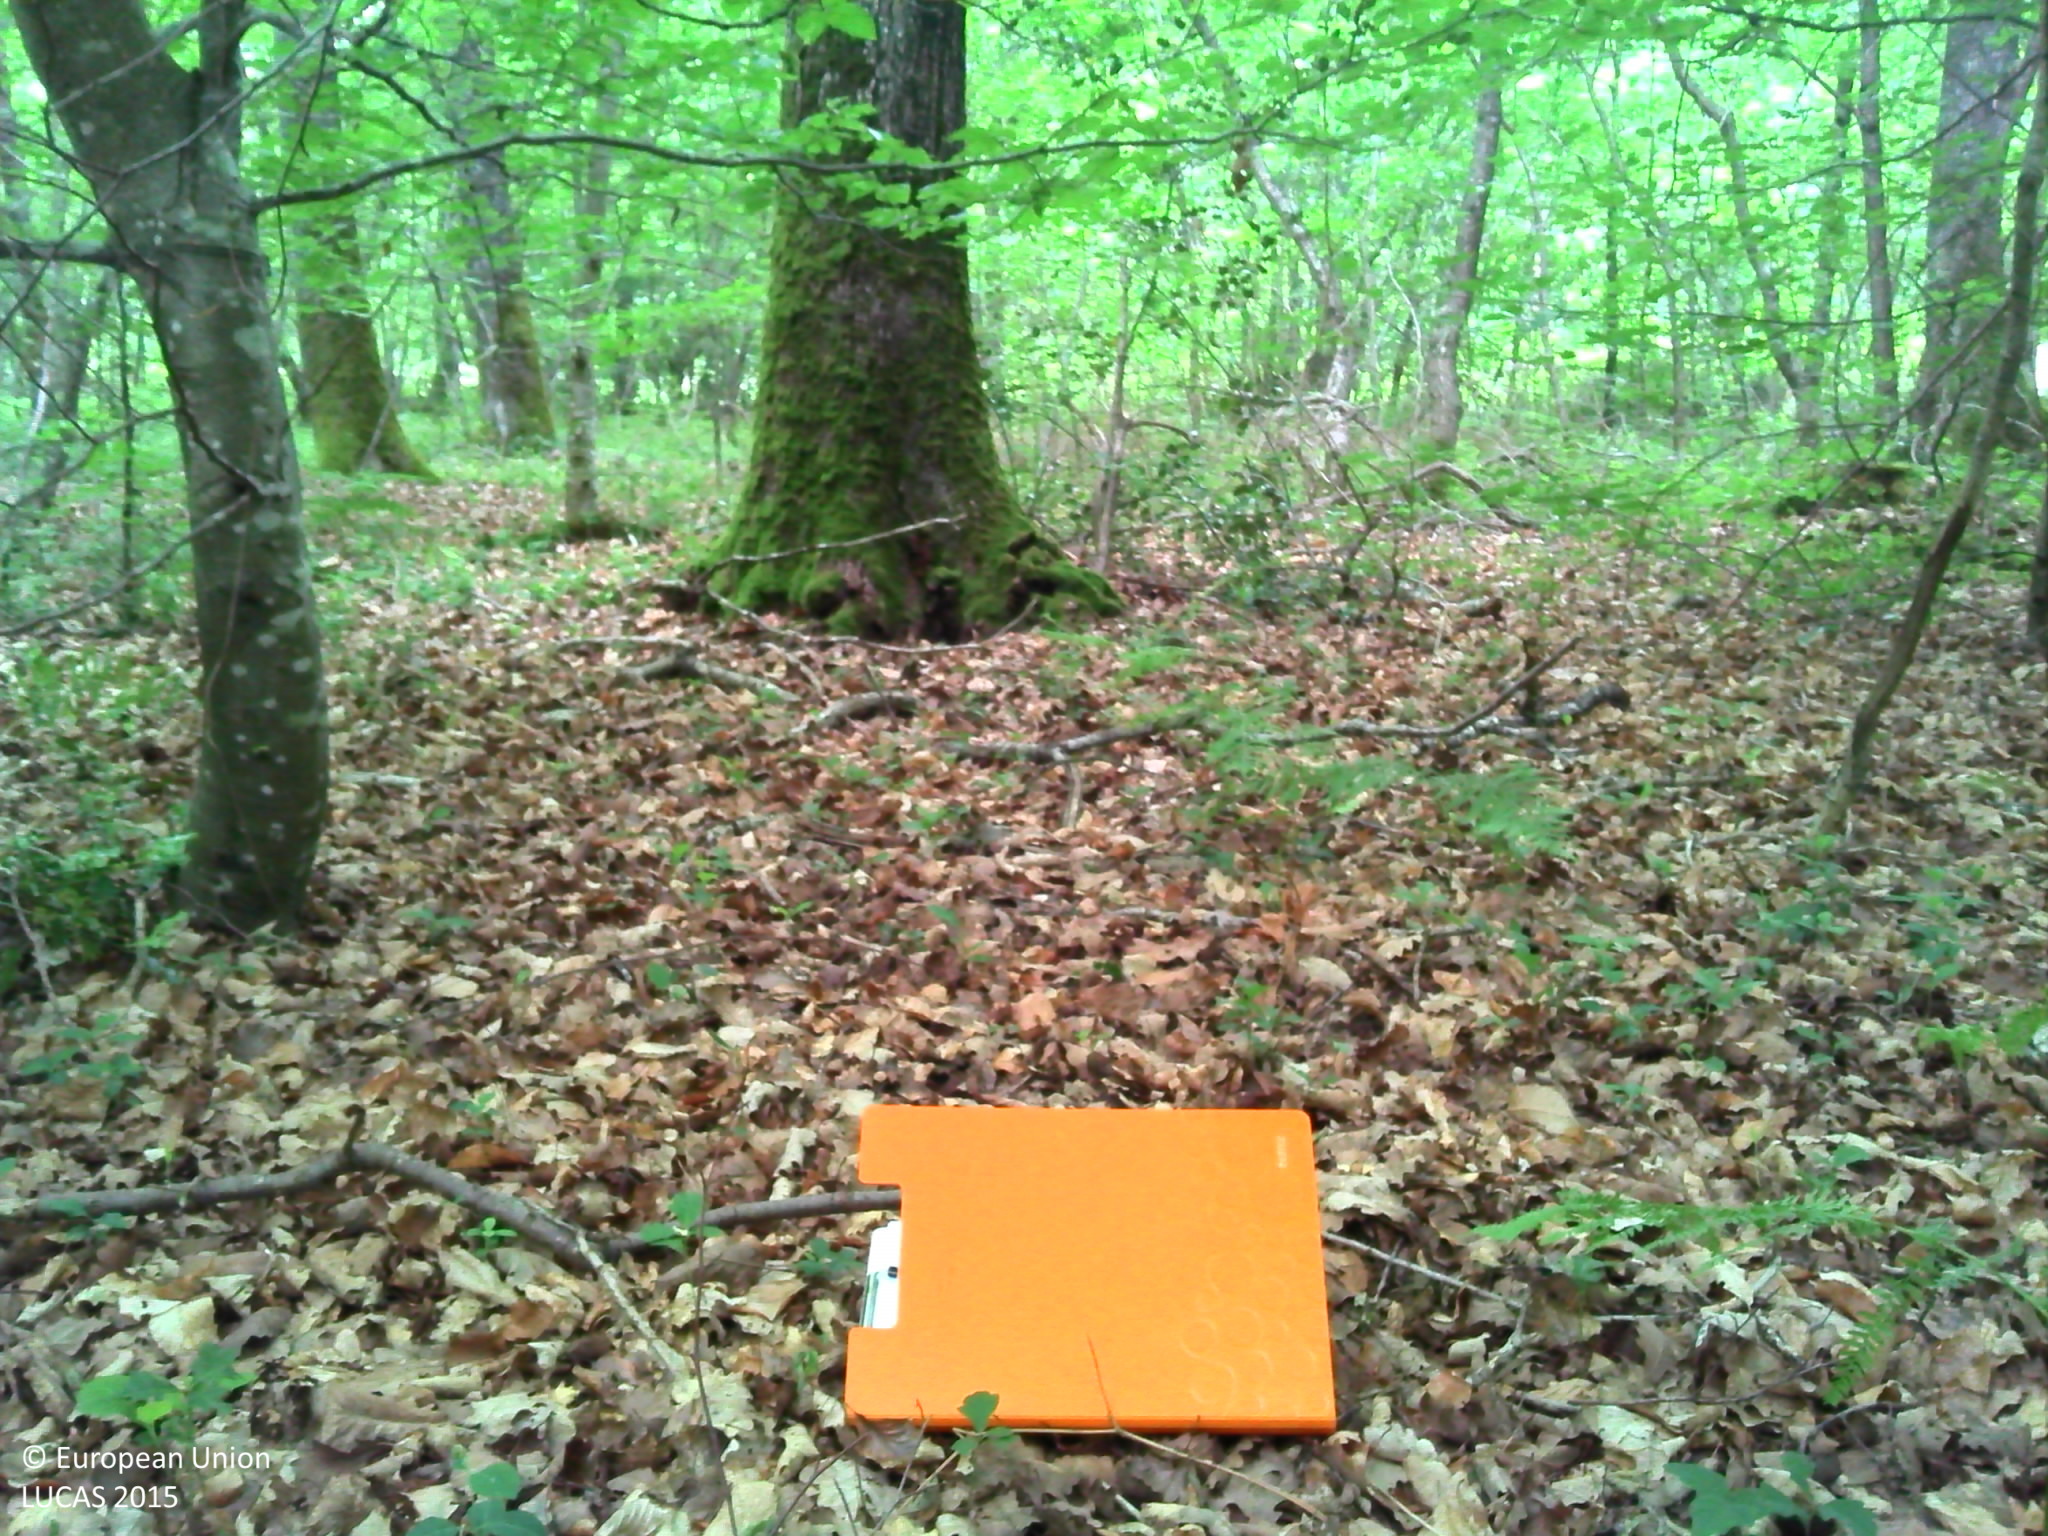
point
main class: Woodland
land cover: Broadleaved woodland
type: beech forest
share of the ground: > 75 %
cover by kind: broadleaved forest trees 90 %, shrubs 10 %
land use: Forestry
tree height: > 5 m
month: May
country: FR
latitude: 47.1358
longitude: 2.7559
